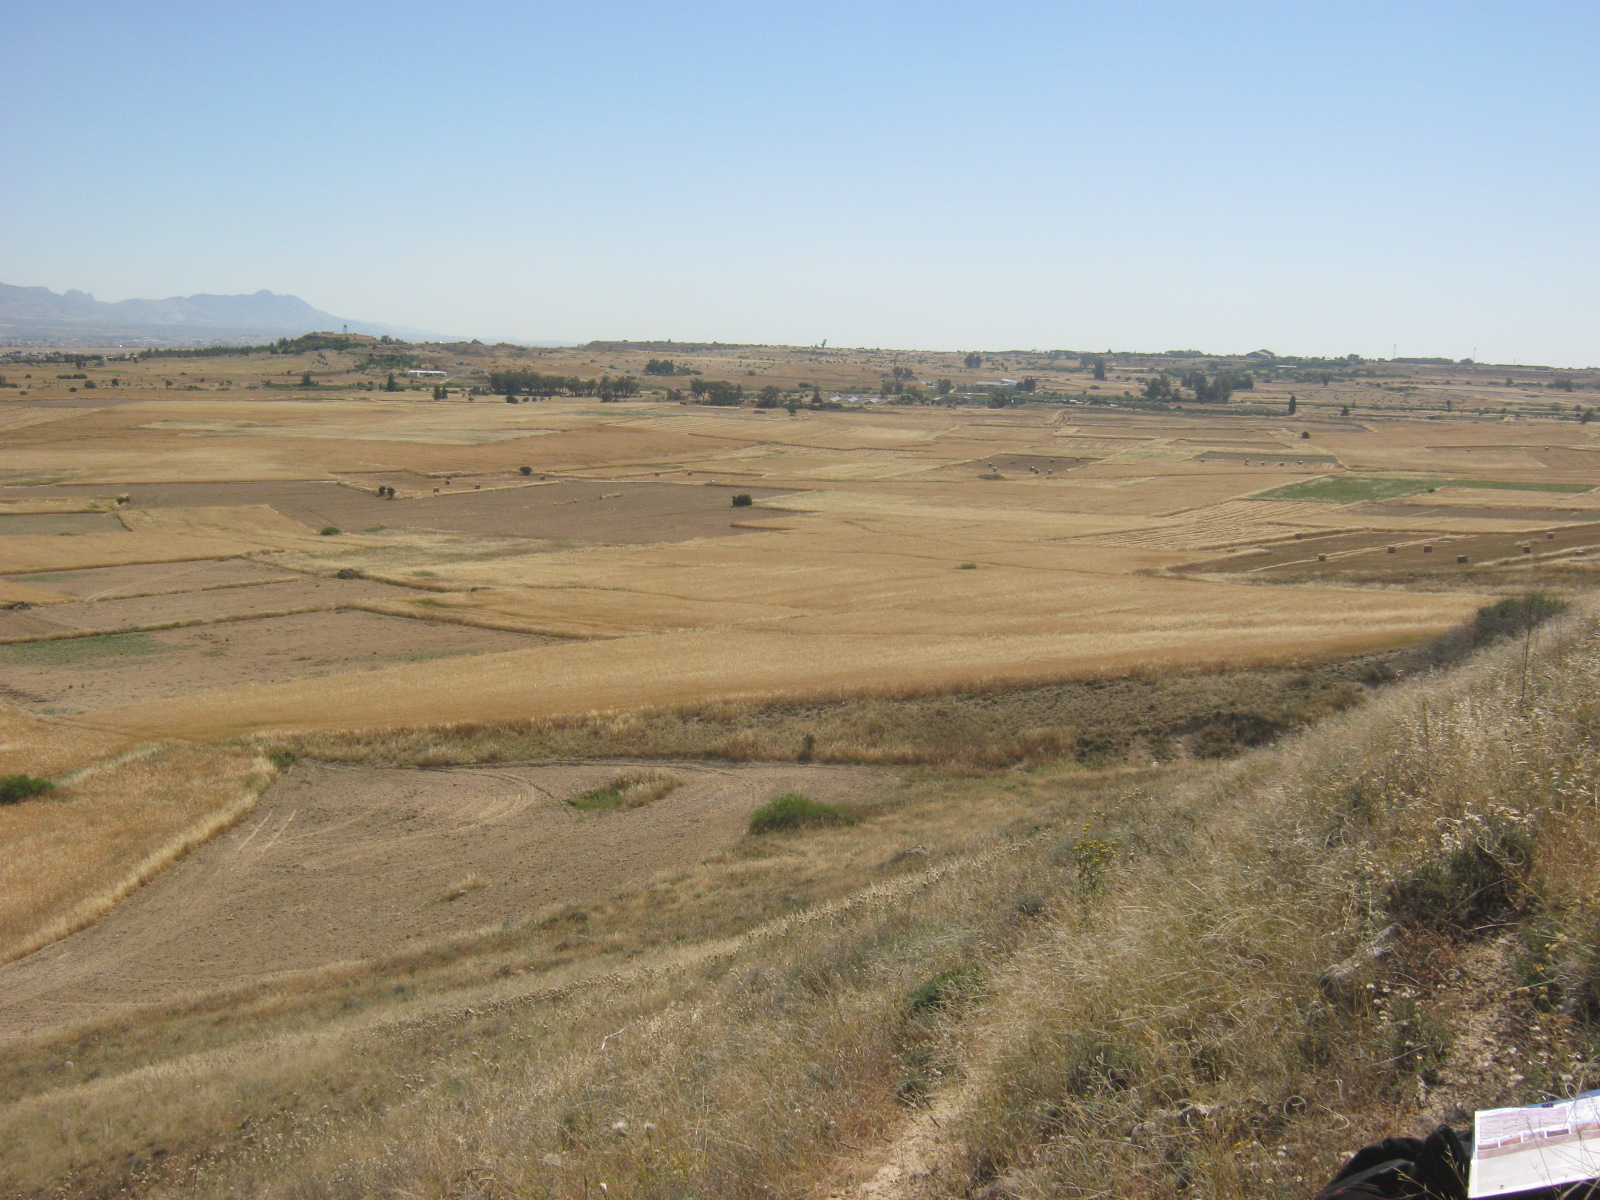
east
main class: Shrubland
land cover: Shrubland without tree cover
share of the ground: 25 - 50 %
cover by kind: unconsolidated bare surface 55 %, shrubs 40 %, herbaceous plants 5 %
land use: Semi-natural and natural areas not in use
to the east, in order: Shrubland without tree cover; Rivers and streams; Common wheat
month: May
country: CY
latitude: 35.1655
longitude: 33.2334
